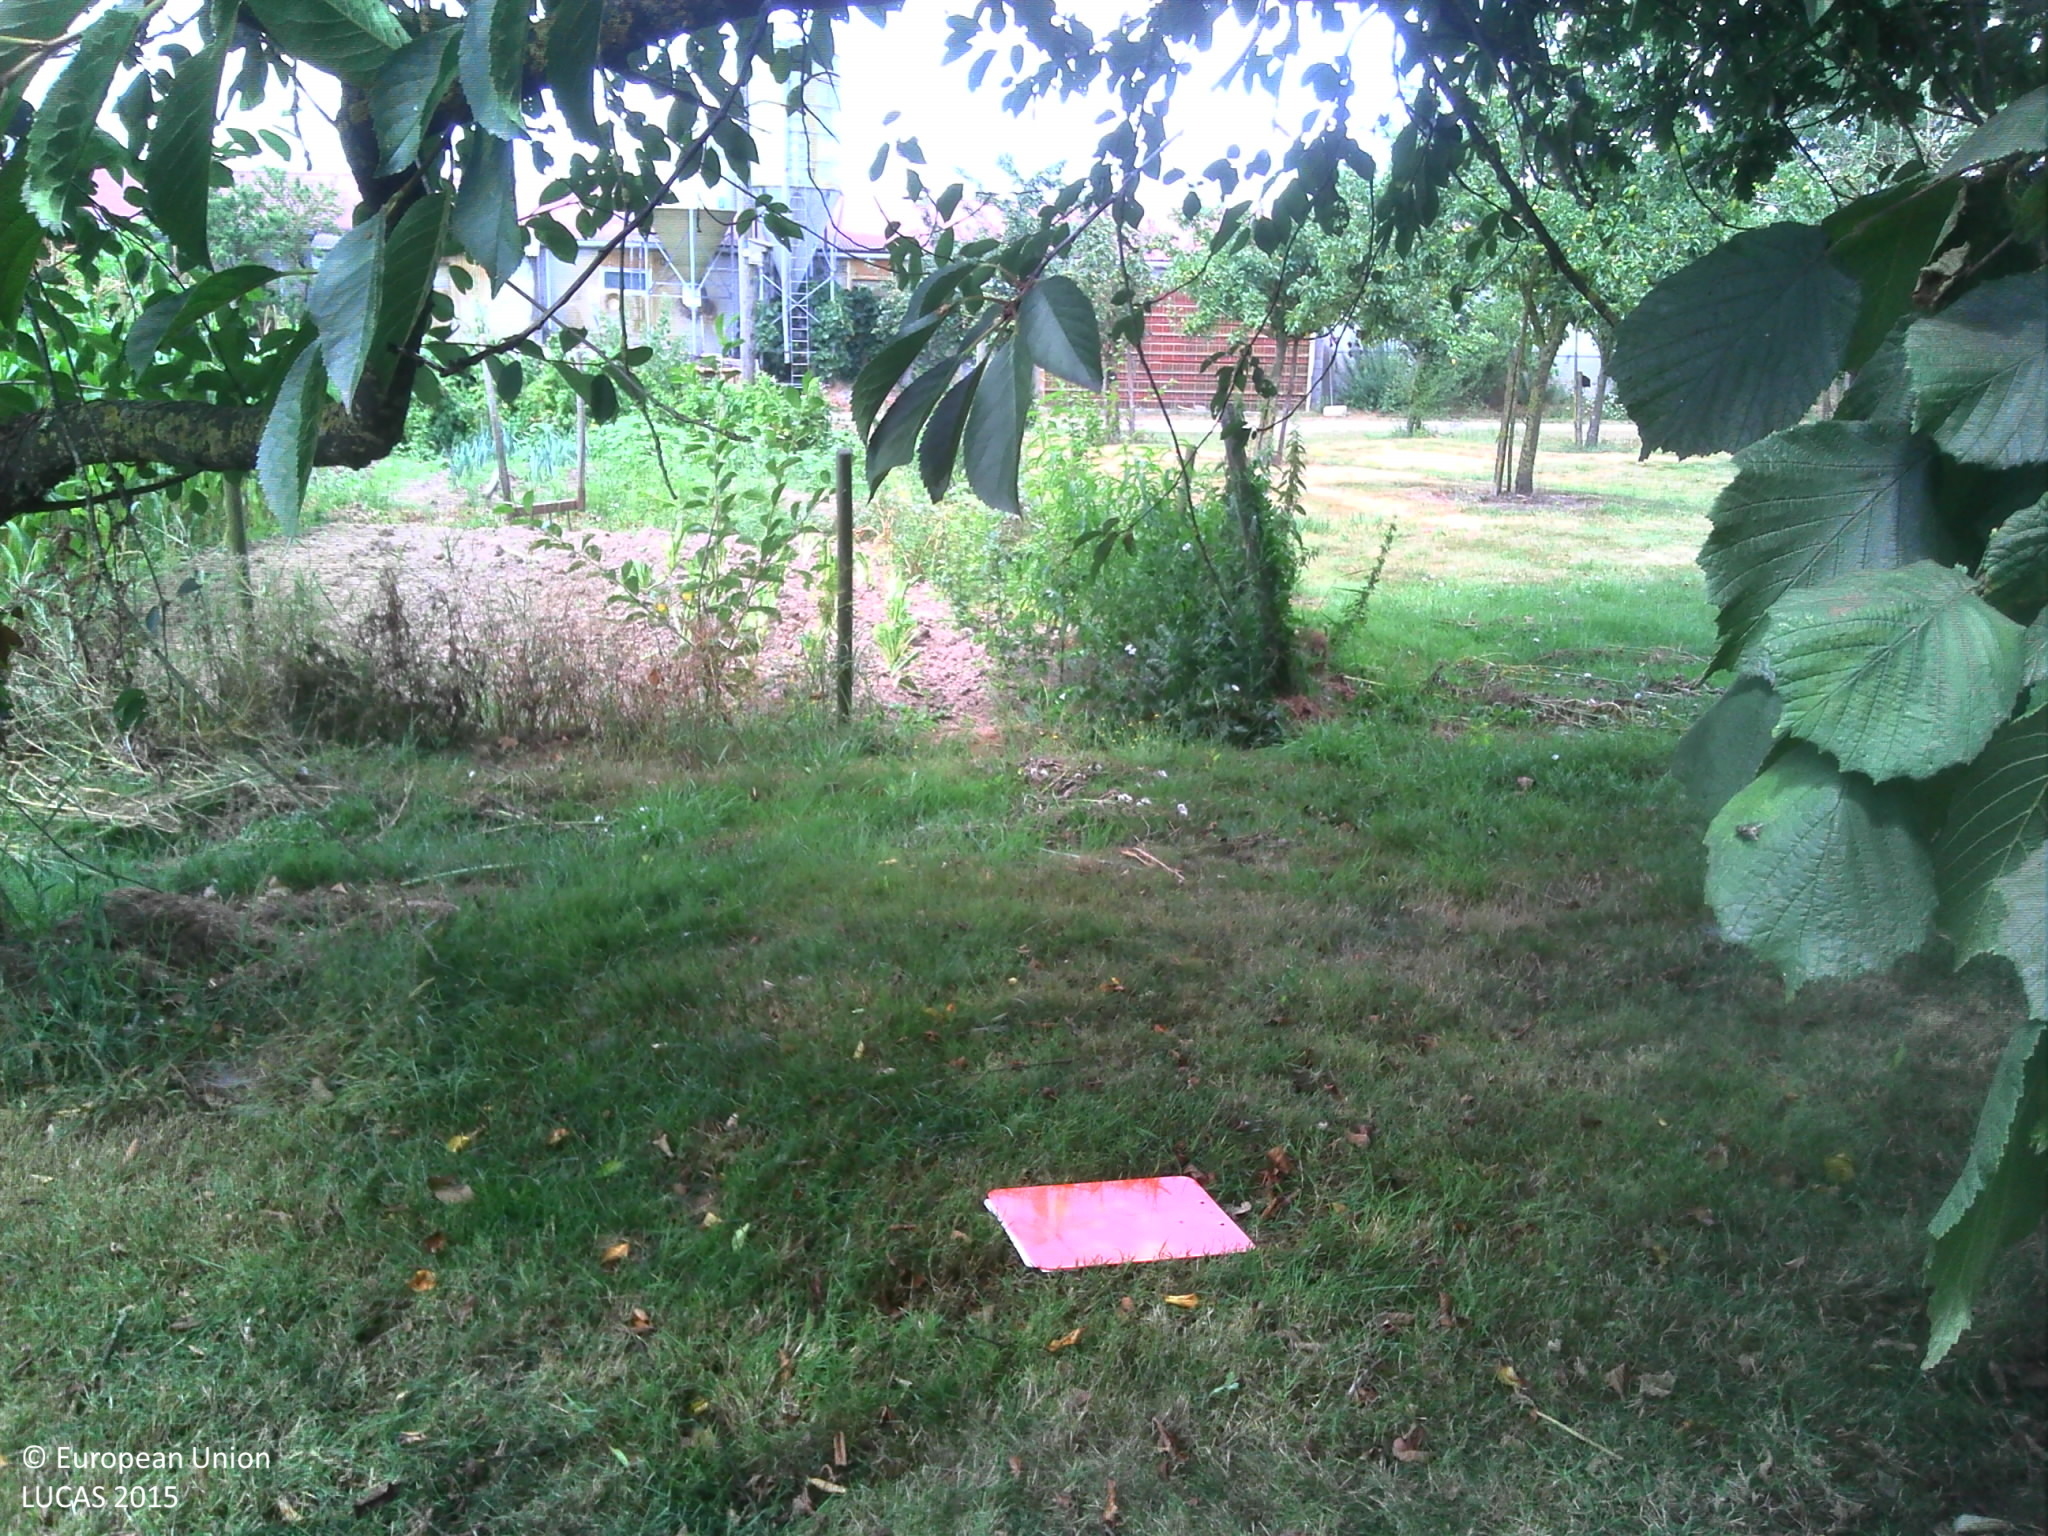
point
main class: Cropland
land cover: Apple fruit
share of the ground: > 75 %
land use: Kitchen garden
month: July
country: FR
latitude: 46.9762
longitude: -1.2235
